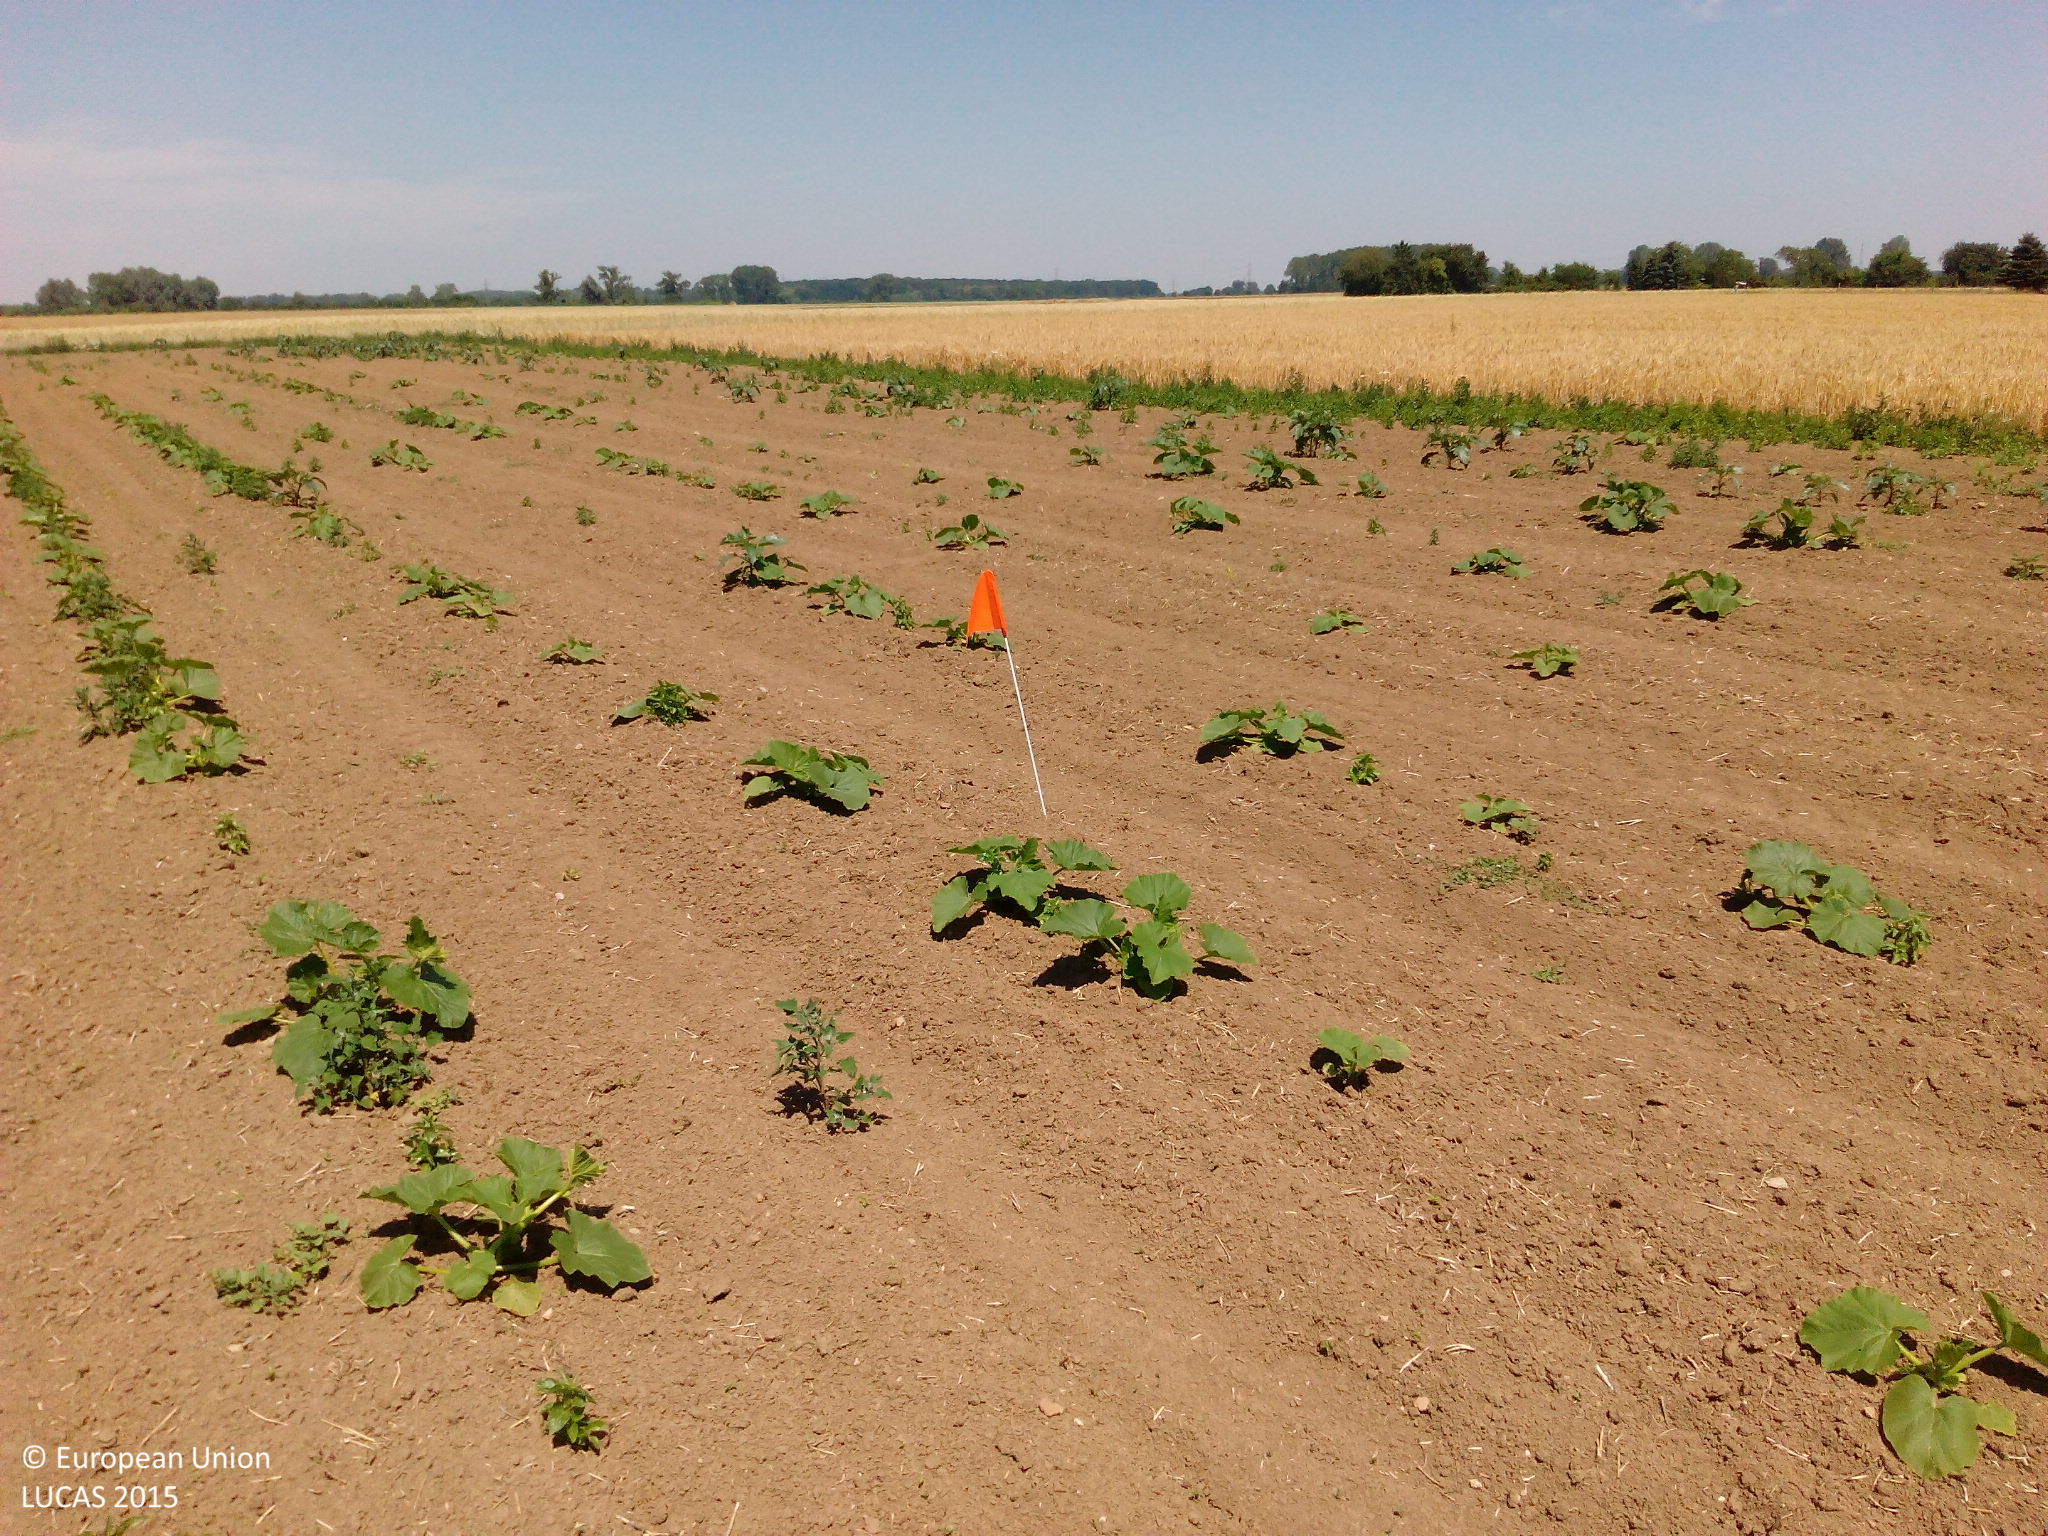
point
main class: Cropland
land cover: Other fresh vegetables
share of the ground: < 10 %
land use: Agriculture (excluding fallow land and kitchen gardens)
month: July
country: DE
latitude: 49.7972
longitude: 8.5417
